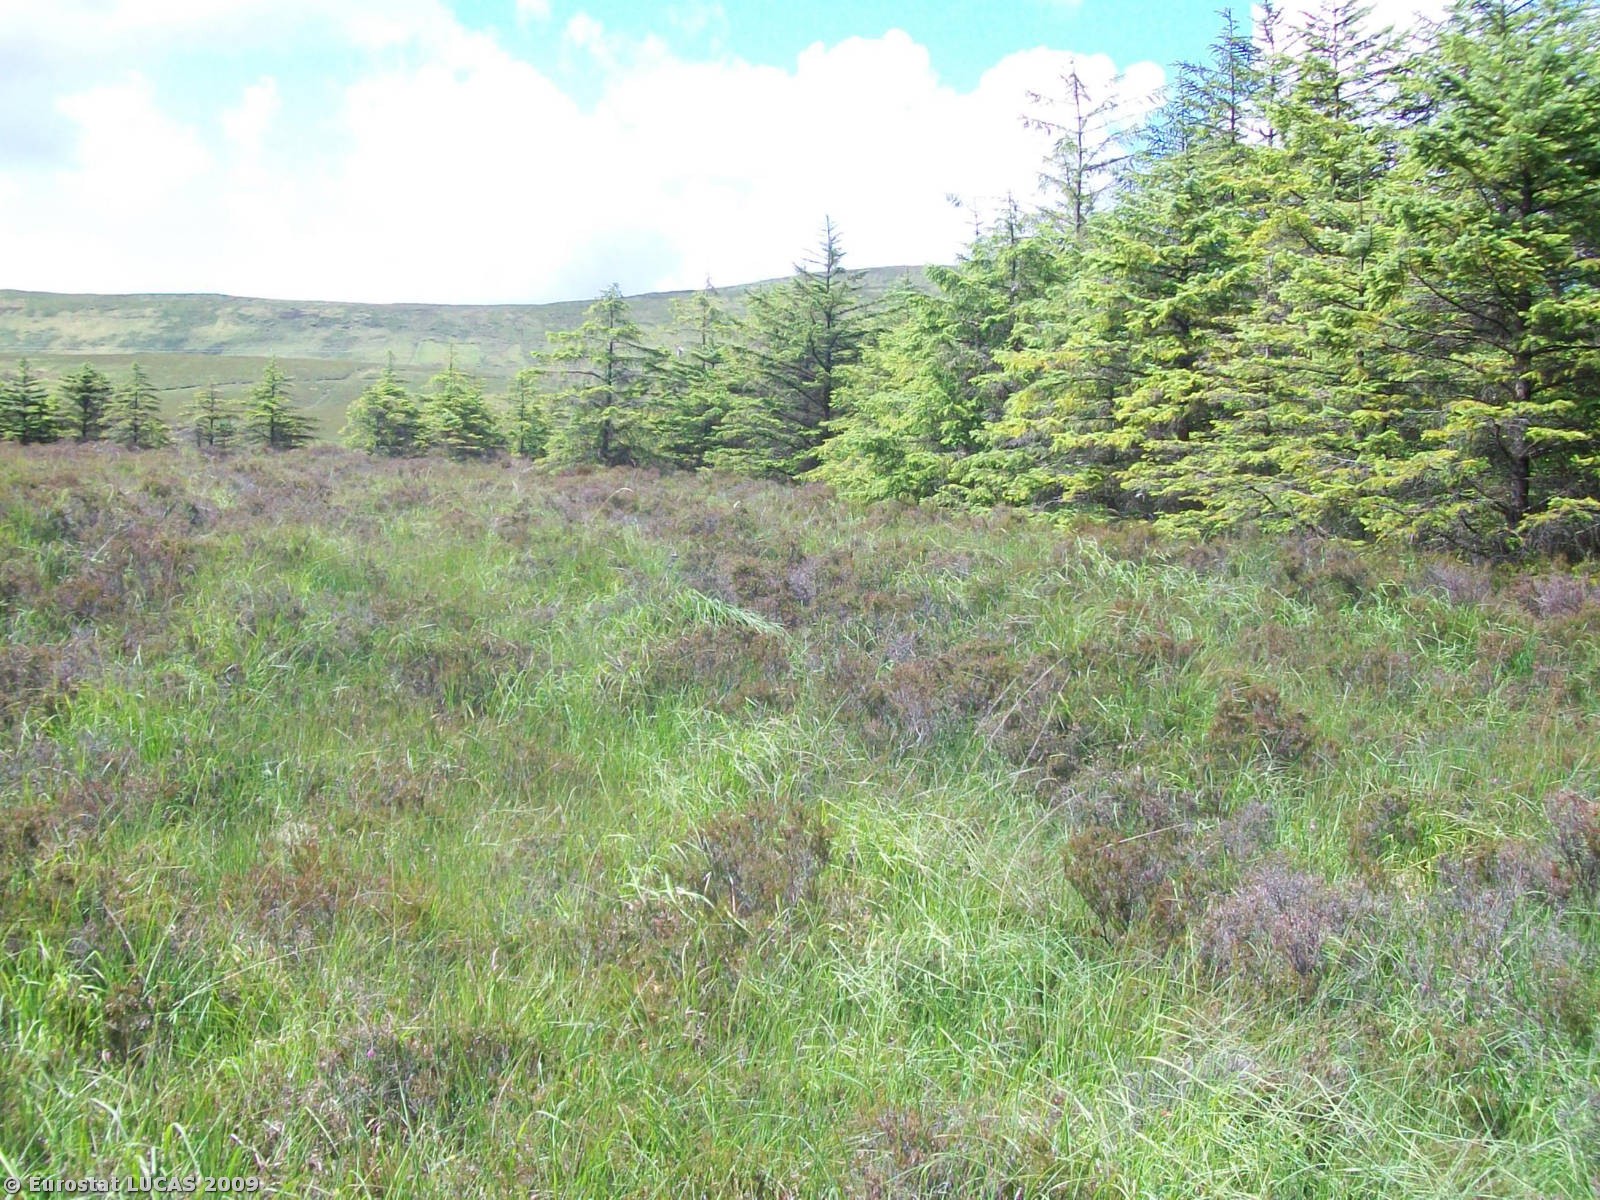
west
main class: Woodland
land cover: Coniferous woodland
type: plantations and self-sown exotic forest
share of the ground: > 75 %
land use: Forestry
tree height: > 5 m
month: July
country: IE
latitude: 54.0942
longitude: -8.9077
